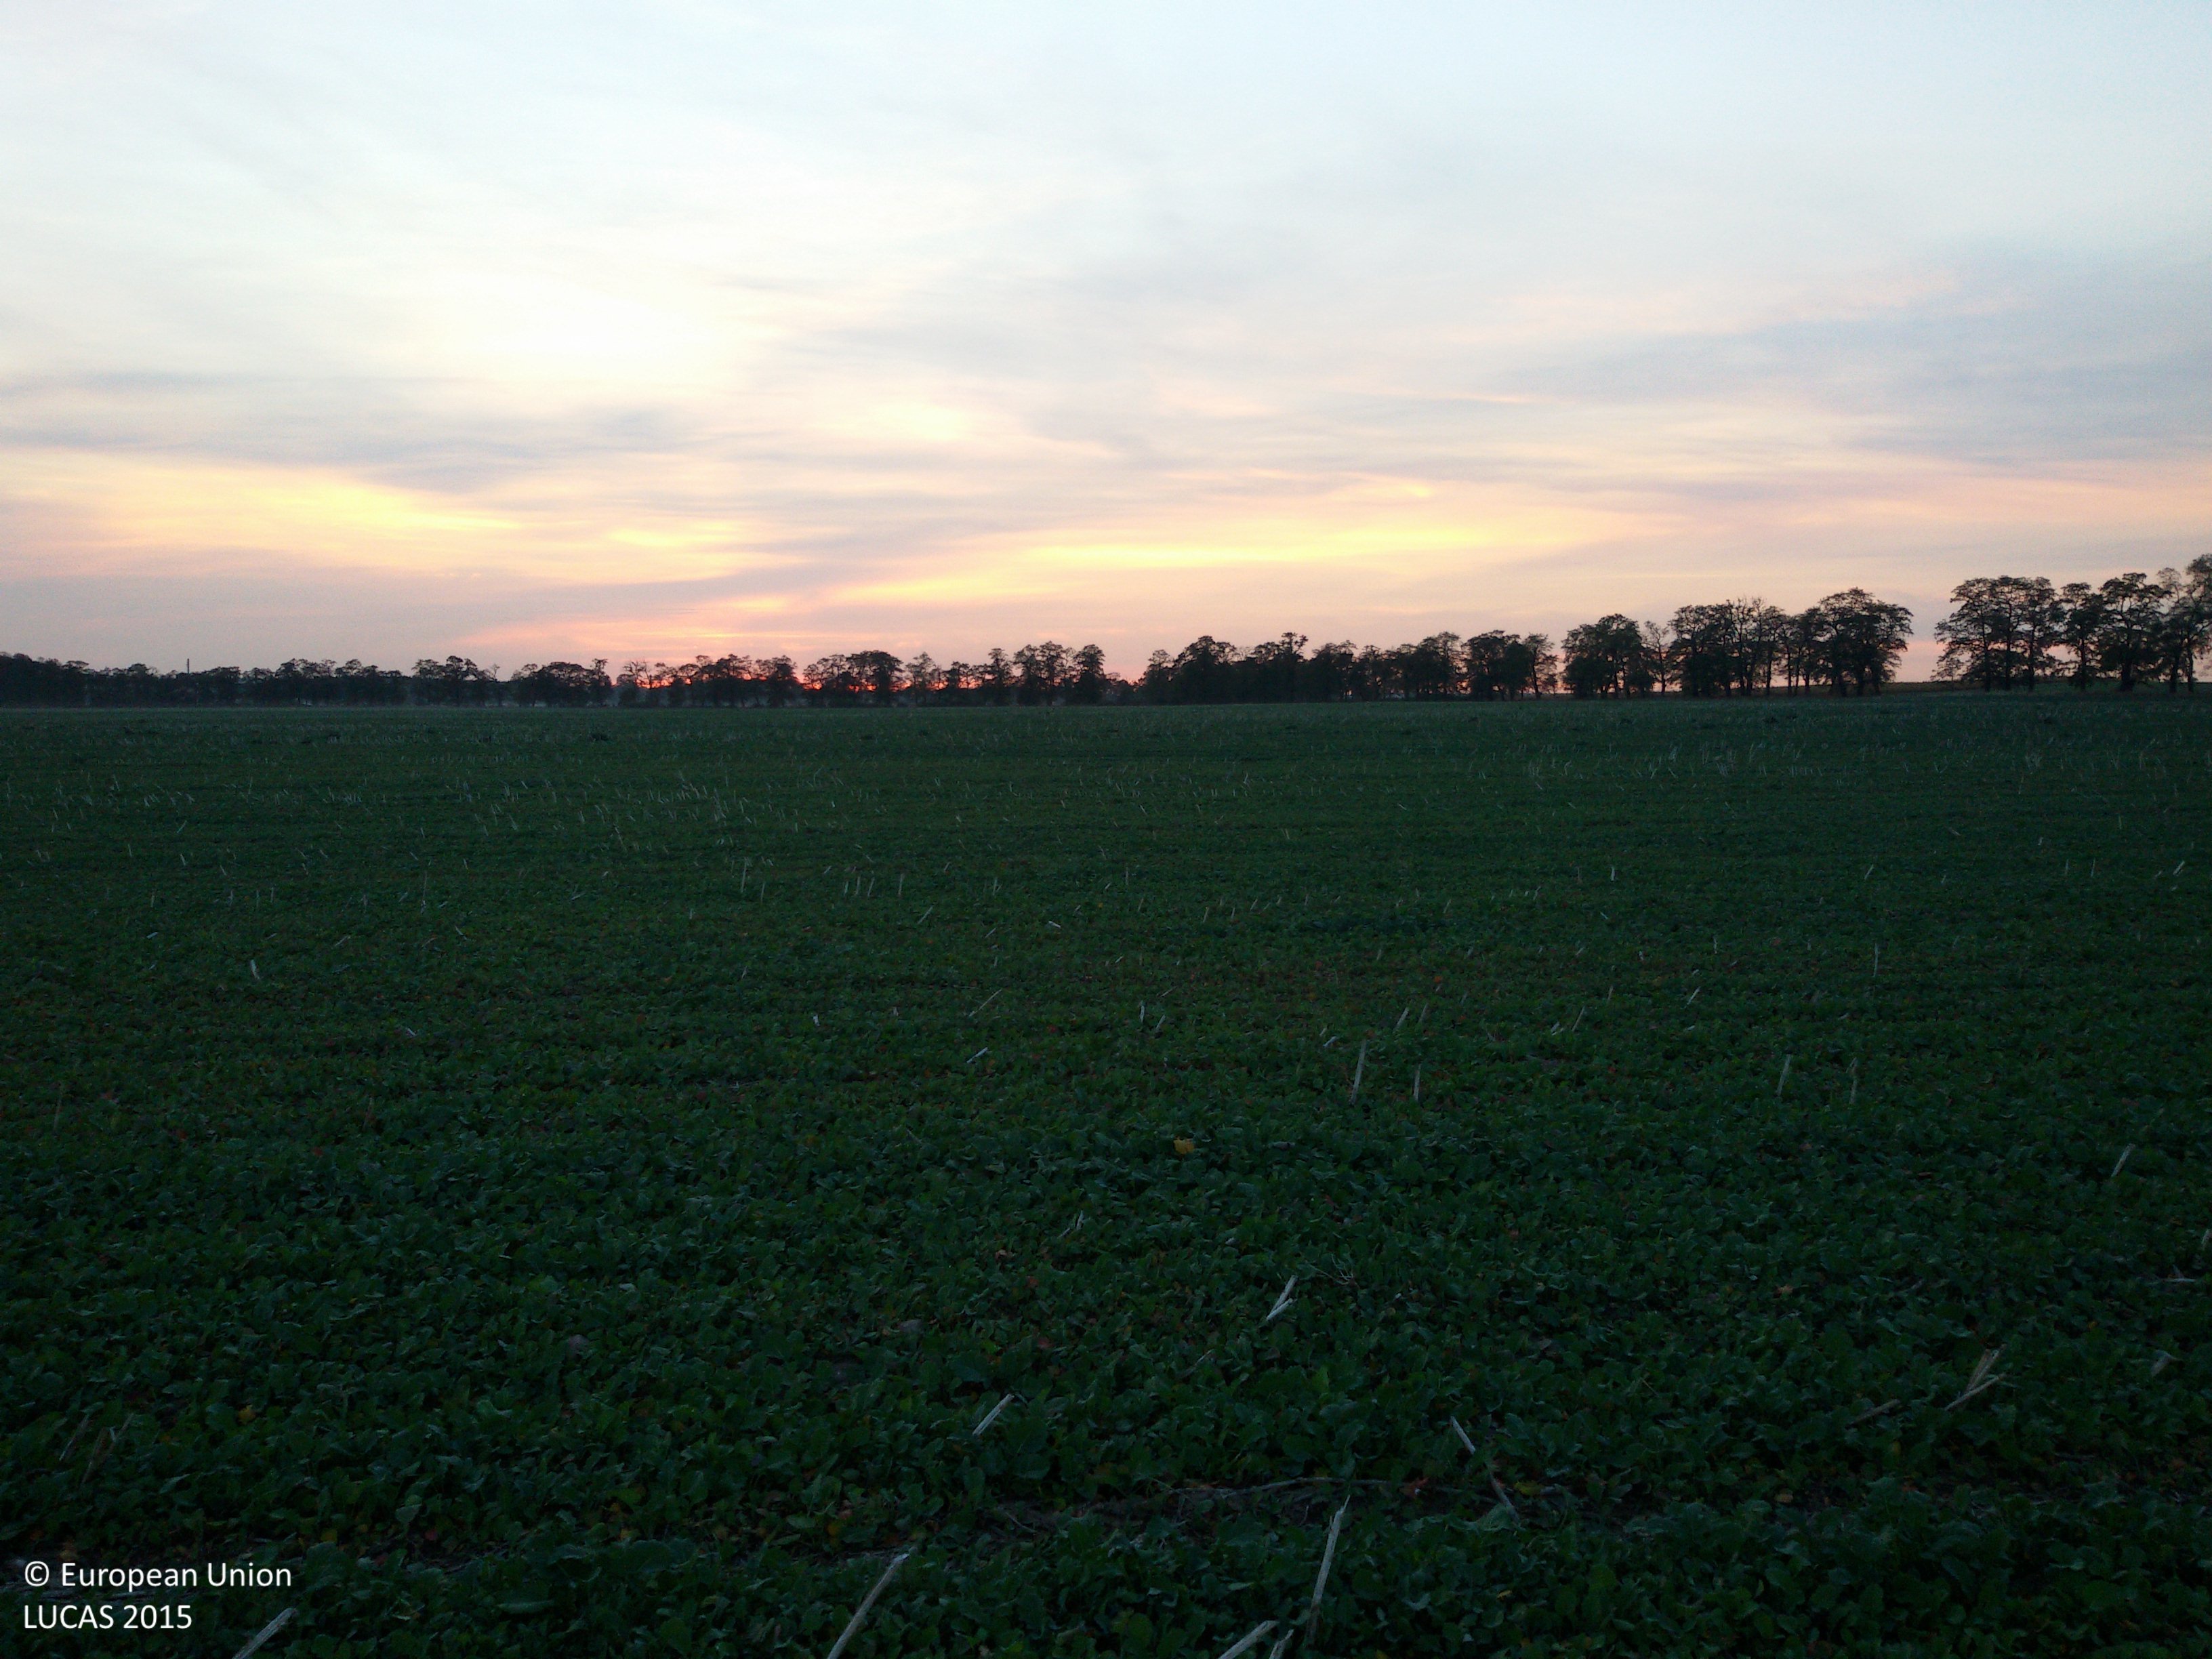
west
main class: Cropland
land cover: Rape and turnip rape
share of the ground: > 75 %
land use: Agriculture (excluding fallow land and kitchen gardens)
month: September
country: PL
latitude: 52.3609
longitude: 17.9892
